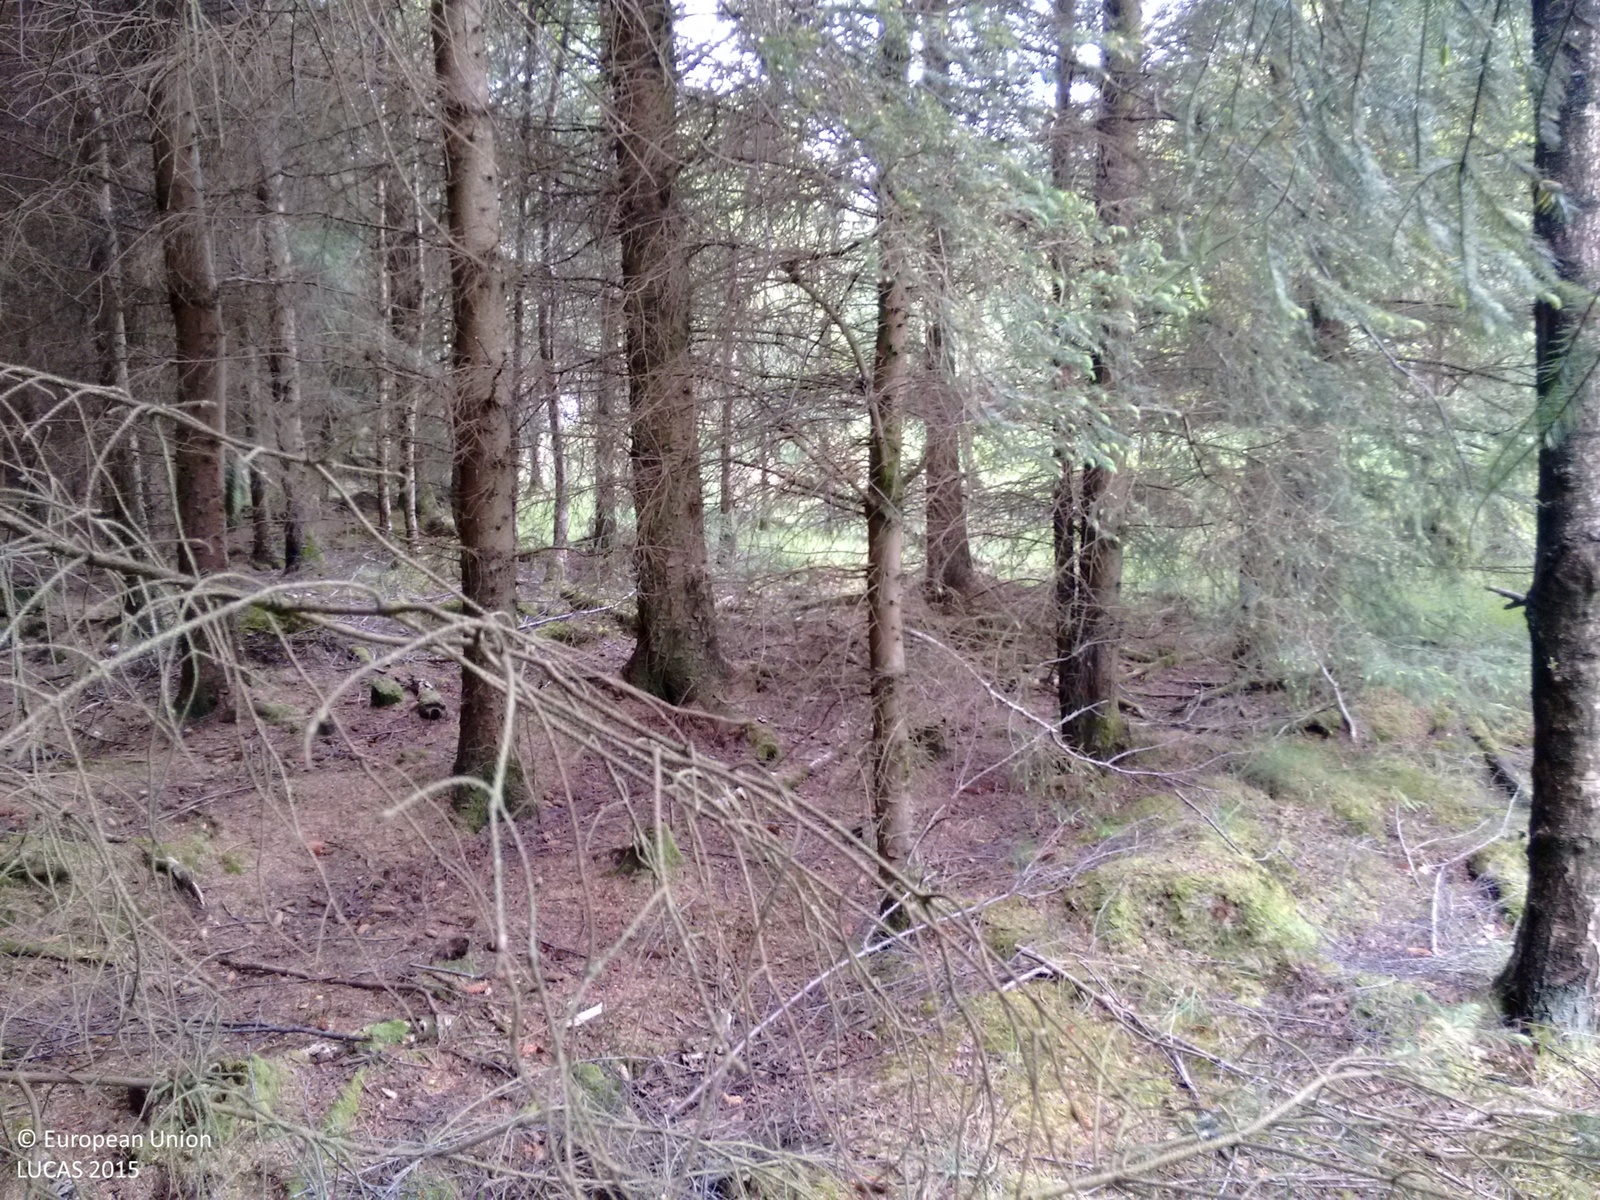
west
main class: Woodland
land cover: Spruce dominated coniferous woodland
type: exotic forest
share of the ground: > 75 %
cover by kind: coniferous forest trees 80 %, broadleaved forest trees 10 %, herbaceous plants 5 %, lichens and mosses 5 %
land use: Forestry
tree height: > 5 m
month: June
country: GB
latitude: 56.8043
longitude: -2.5856
